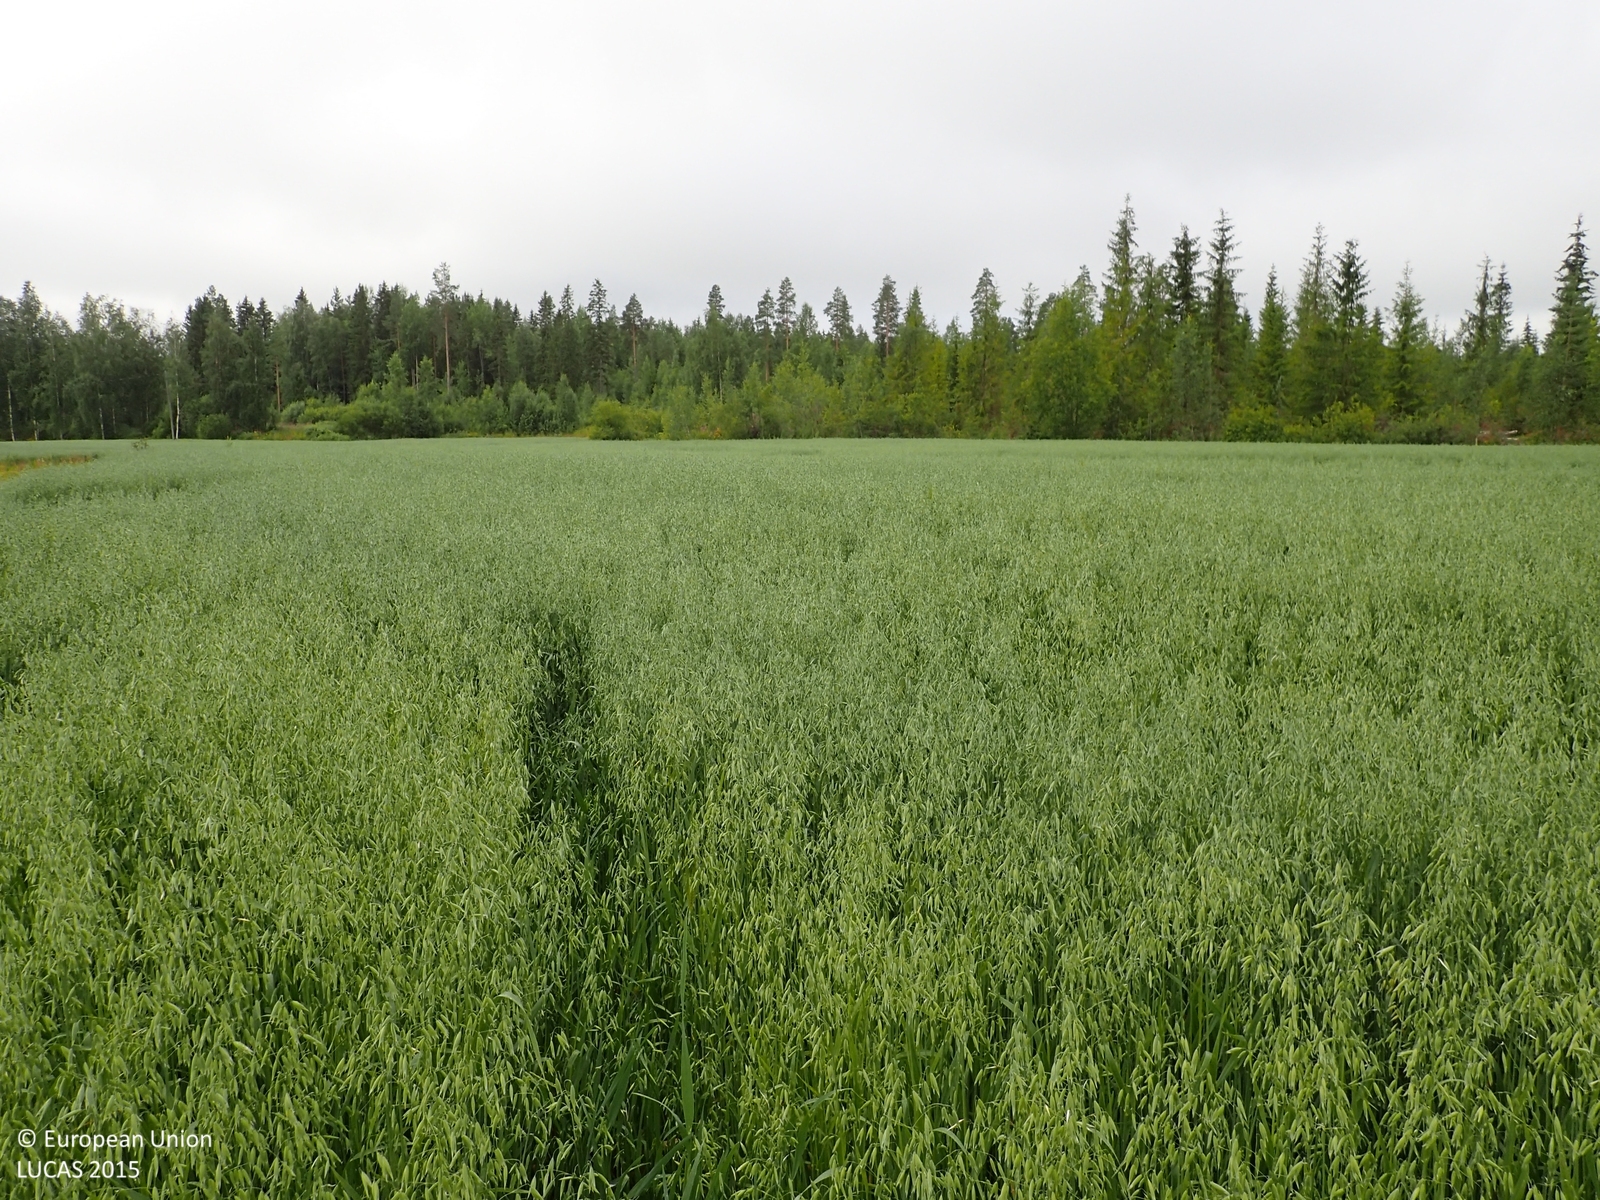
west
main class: Cropland
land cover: Oats
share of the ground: > 75 %
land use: Agriculture (excluding fallow land and kitchen gardens)
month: July
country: FI
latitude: 62.9679
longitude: 22.4964
